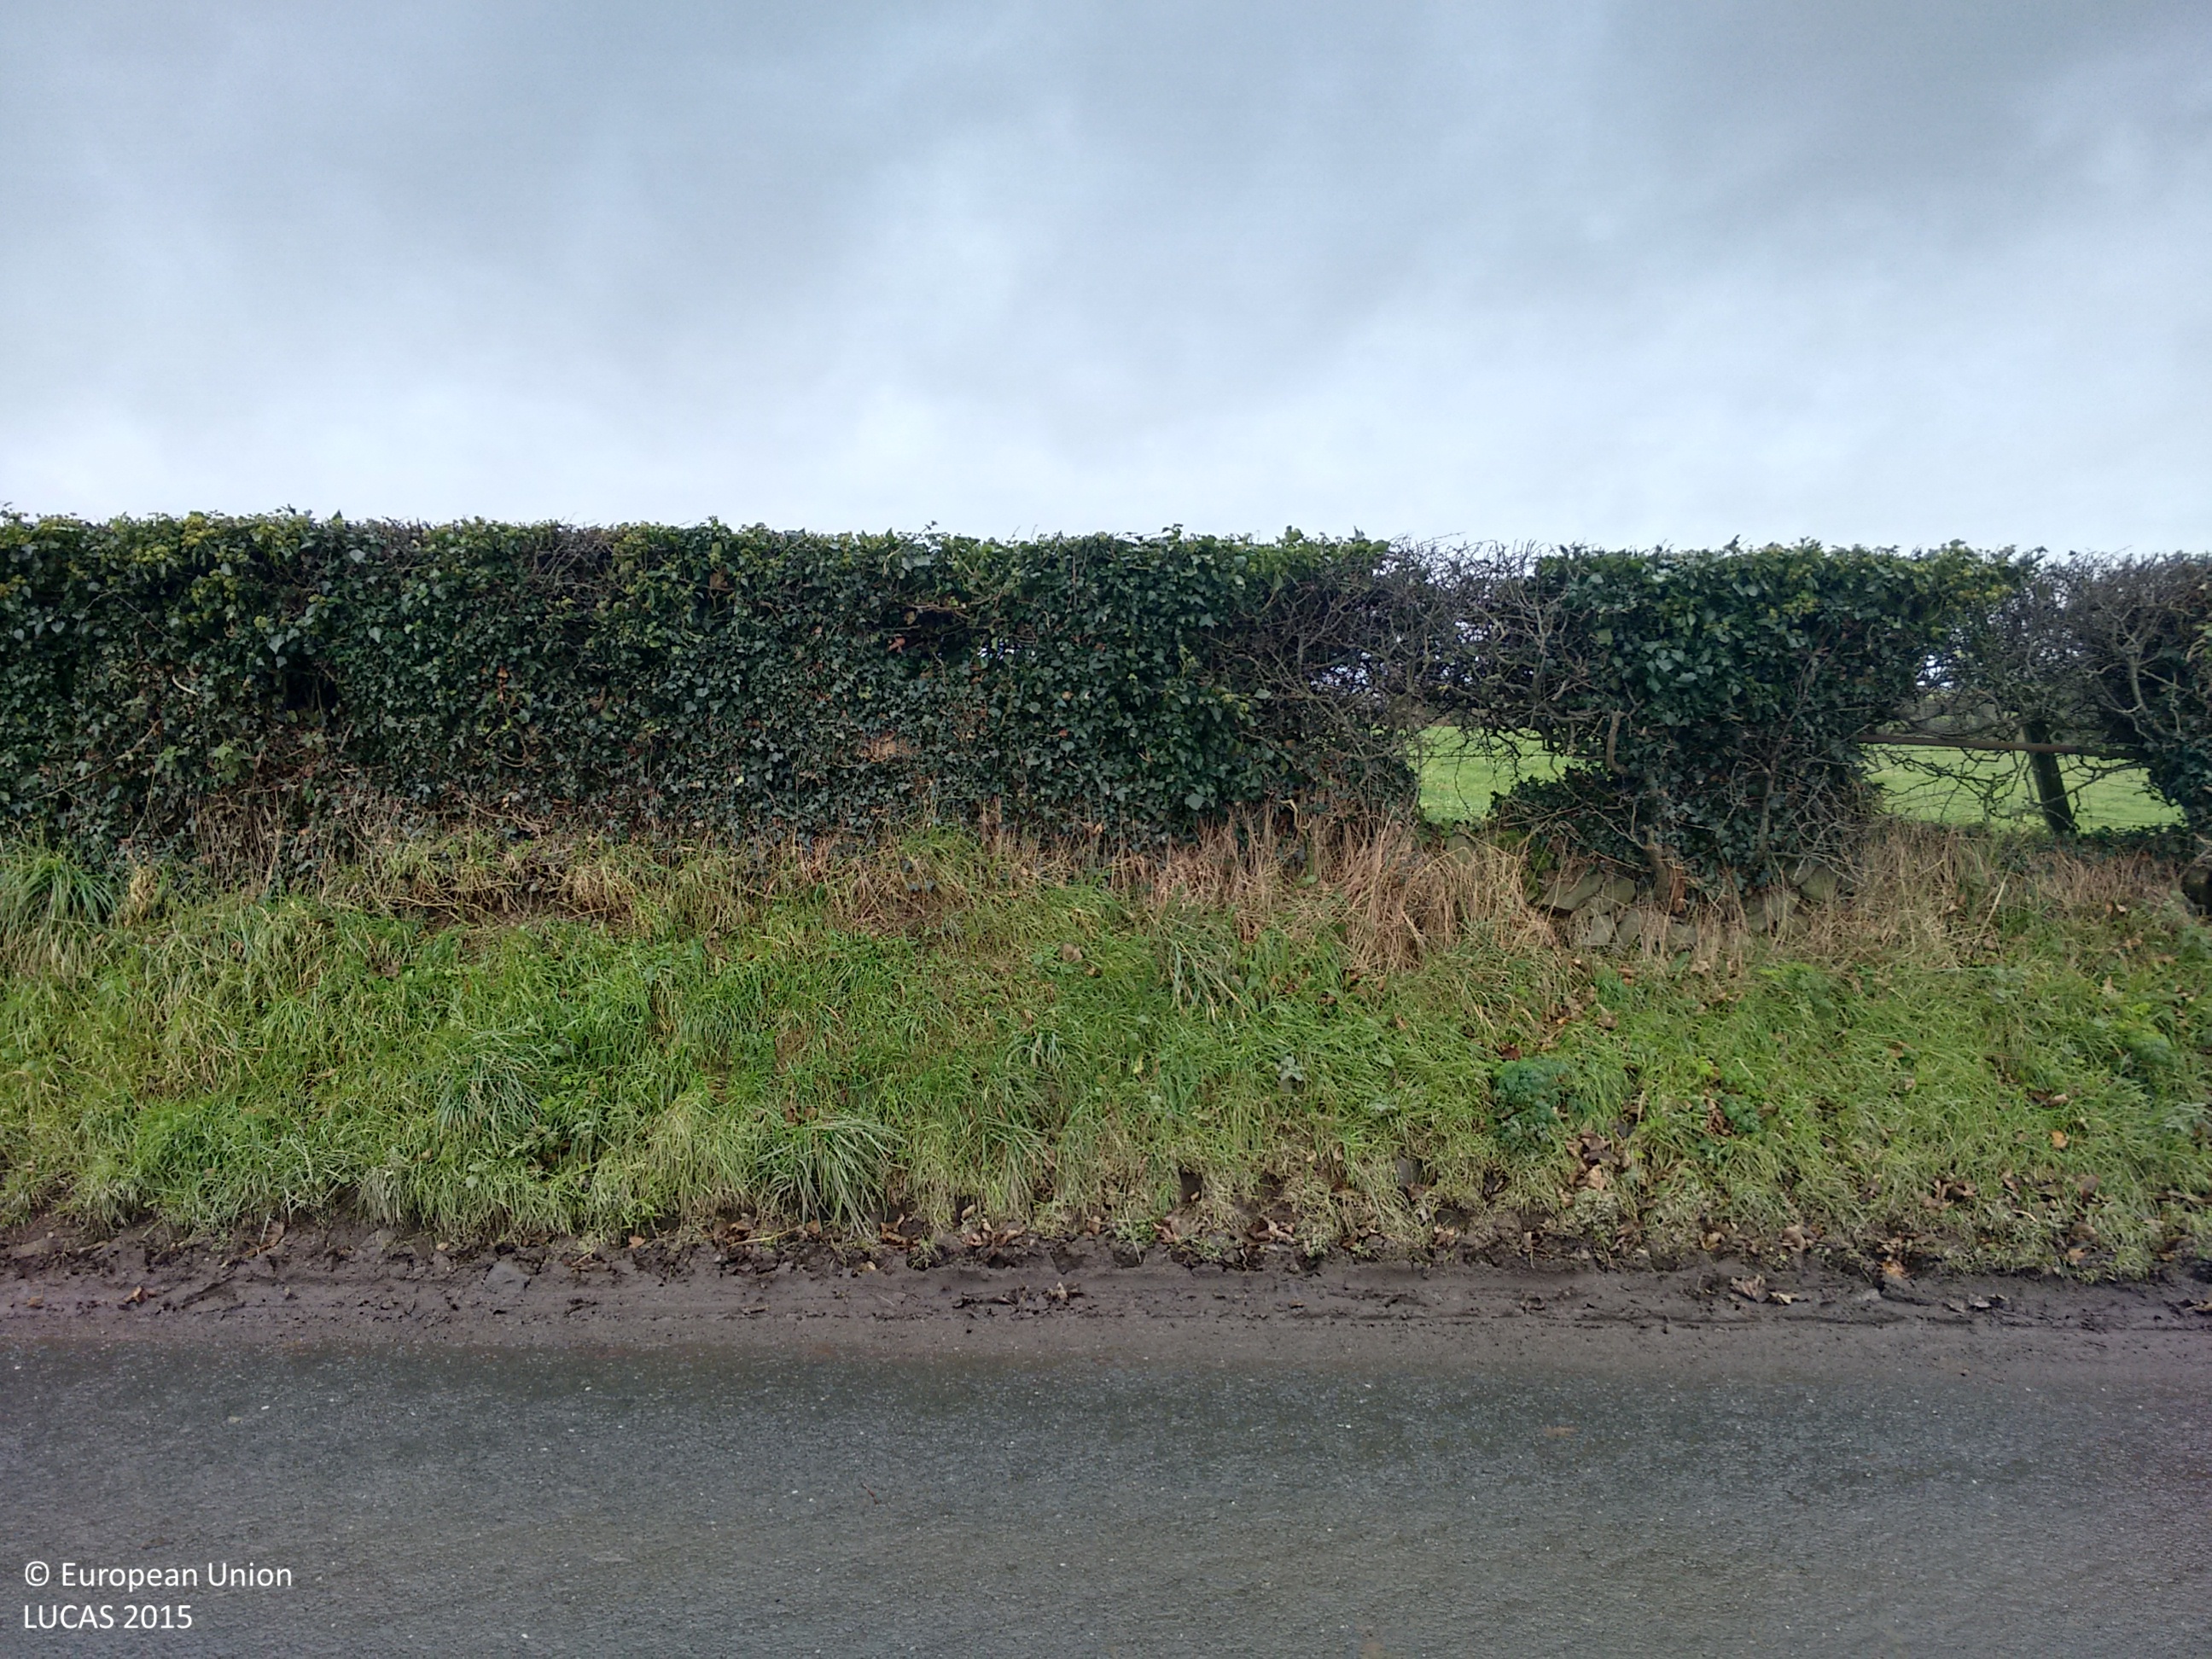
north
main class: Grassland
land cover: Grassland with sparse tree/shrub cover
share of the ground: > 75 %
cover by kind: herbaceous plants 95 %, broadleaved forest trees 5 %
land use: Fallow land
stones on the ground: > 50 %
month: November
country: GB
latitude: 54.6154
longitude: -5.6311
